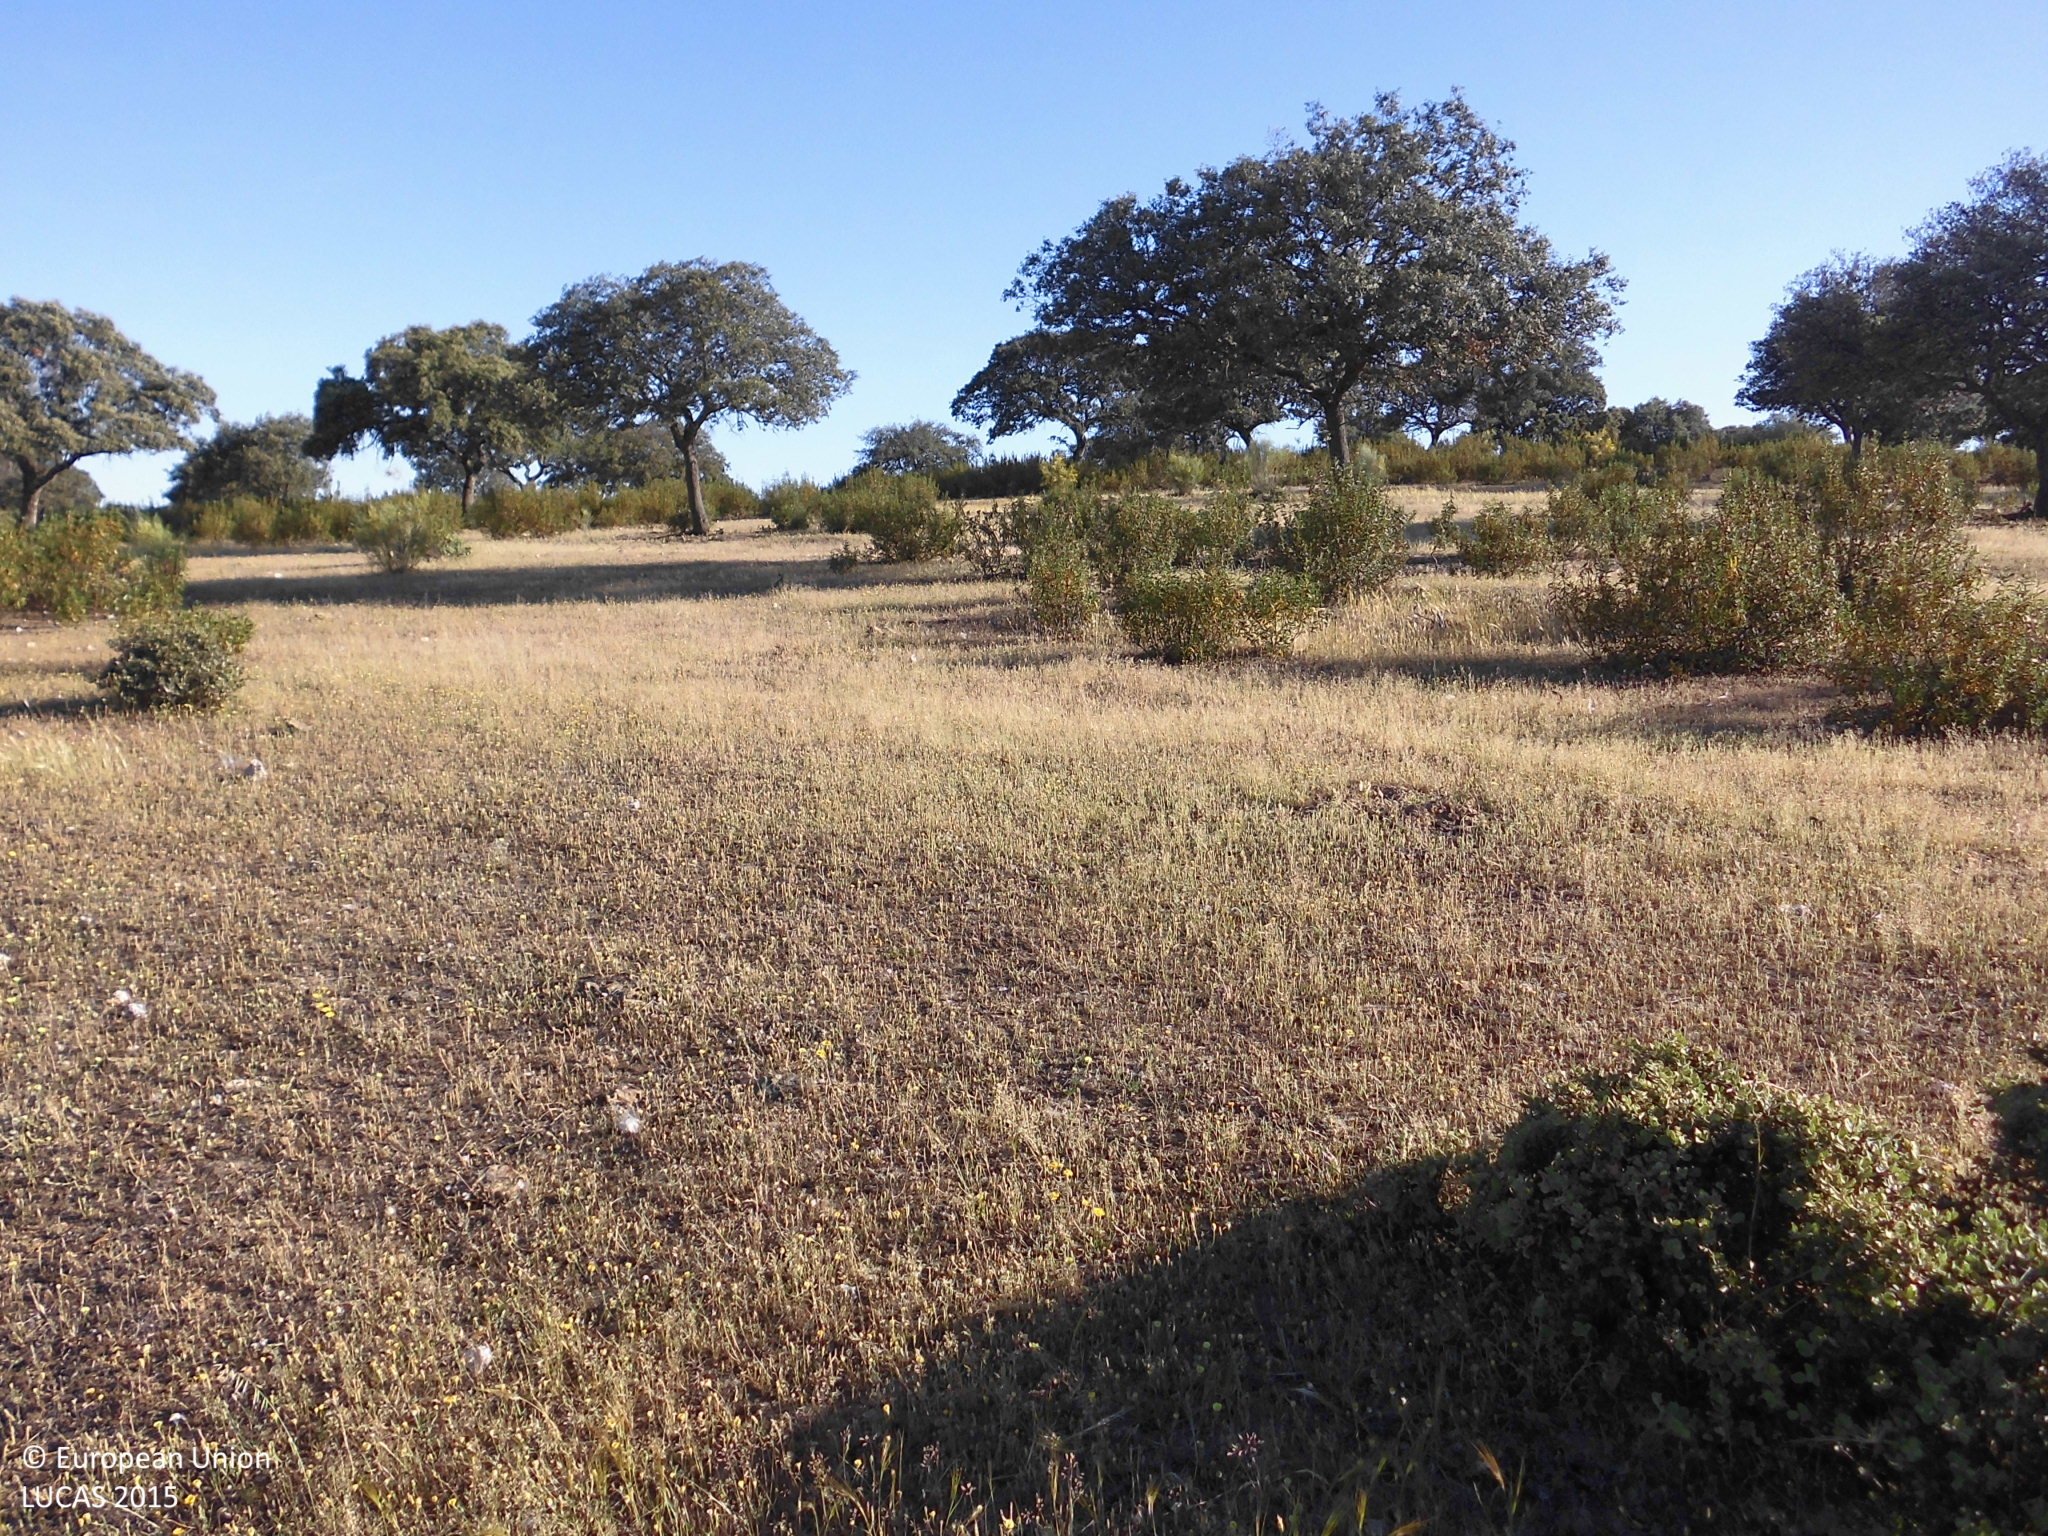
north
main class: Woodland
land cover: Broadleaved woodland
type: broadleaved evergreen forest
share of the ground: 10 - 25 %
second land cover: Grassland without tree/shrub cover
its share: > 75 %
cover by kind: herbaceous plants 50 %, broadleaved forest trees 25 %, shrubs 25 %
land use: Forestry
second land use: Agriculture (excluding fallow land and kitchen gardens)
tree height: > 5 m
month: May
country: ES
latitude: 39.5083
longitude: -7.0041
